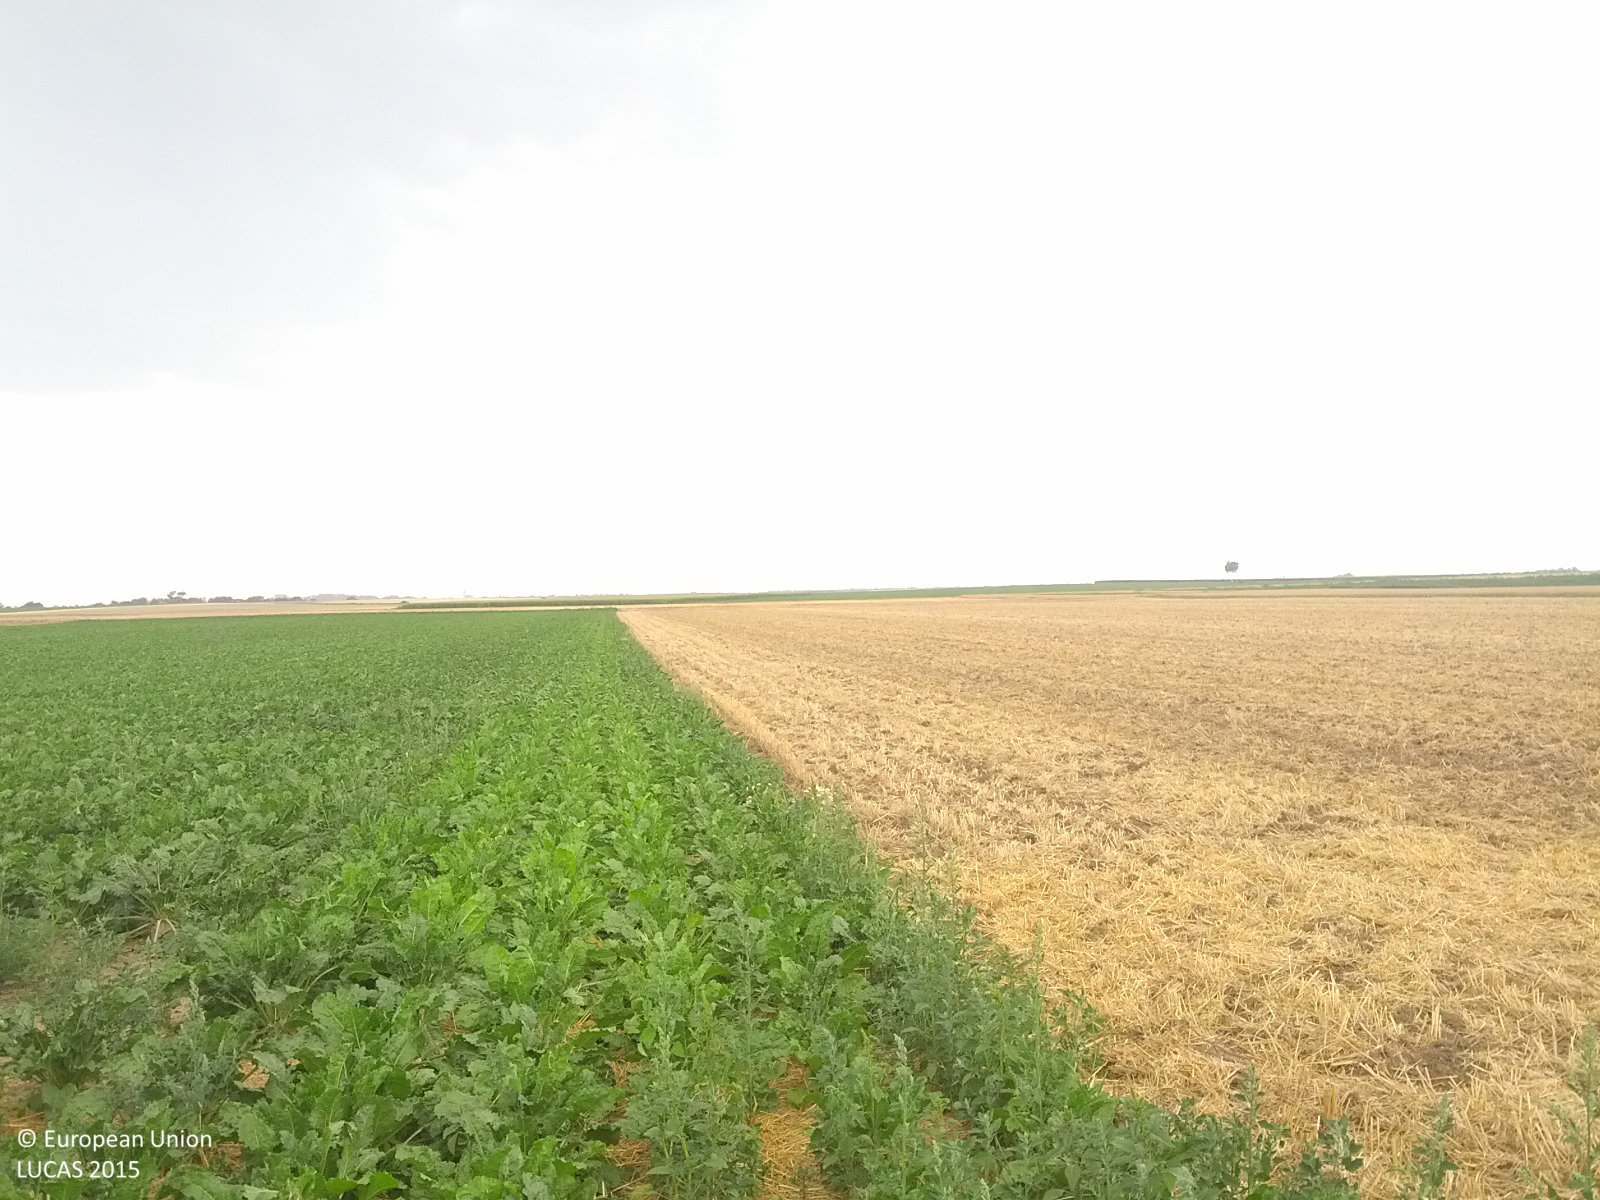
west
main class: Cropland
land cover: Sugar beet
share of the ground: > 75 %
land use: Agriculture (excluding fallow land and kitchen gardens)
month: July
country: AT
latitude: 48.4171
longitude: 16.0711
